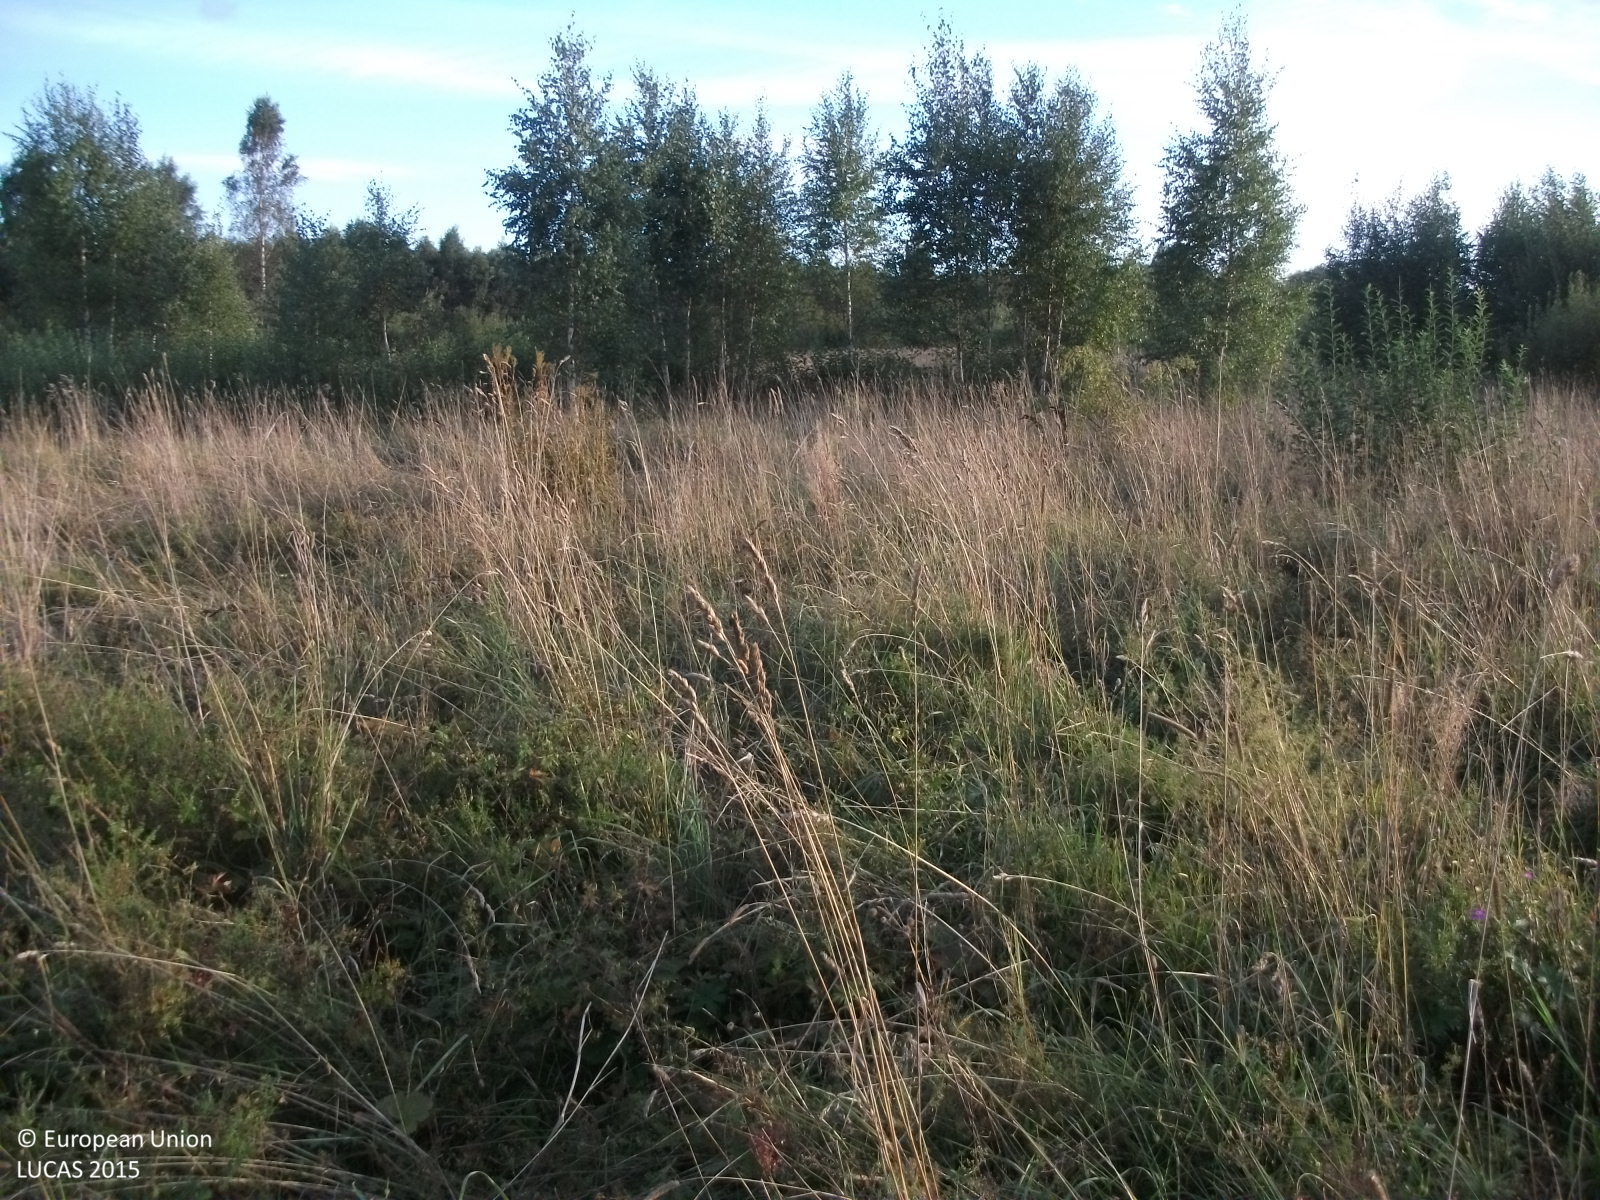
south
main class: Grassland
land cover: Grassland with sparse tree/shrub cover
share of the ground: > 75 %
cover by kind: herbaceous plants 90 %, broadleaved forest trees 5 %, shrubs 5 %
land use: Abandoned areas
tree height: < 5 m
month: September
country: LV
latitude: 57.5714
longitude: 24.5204
